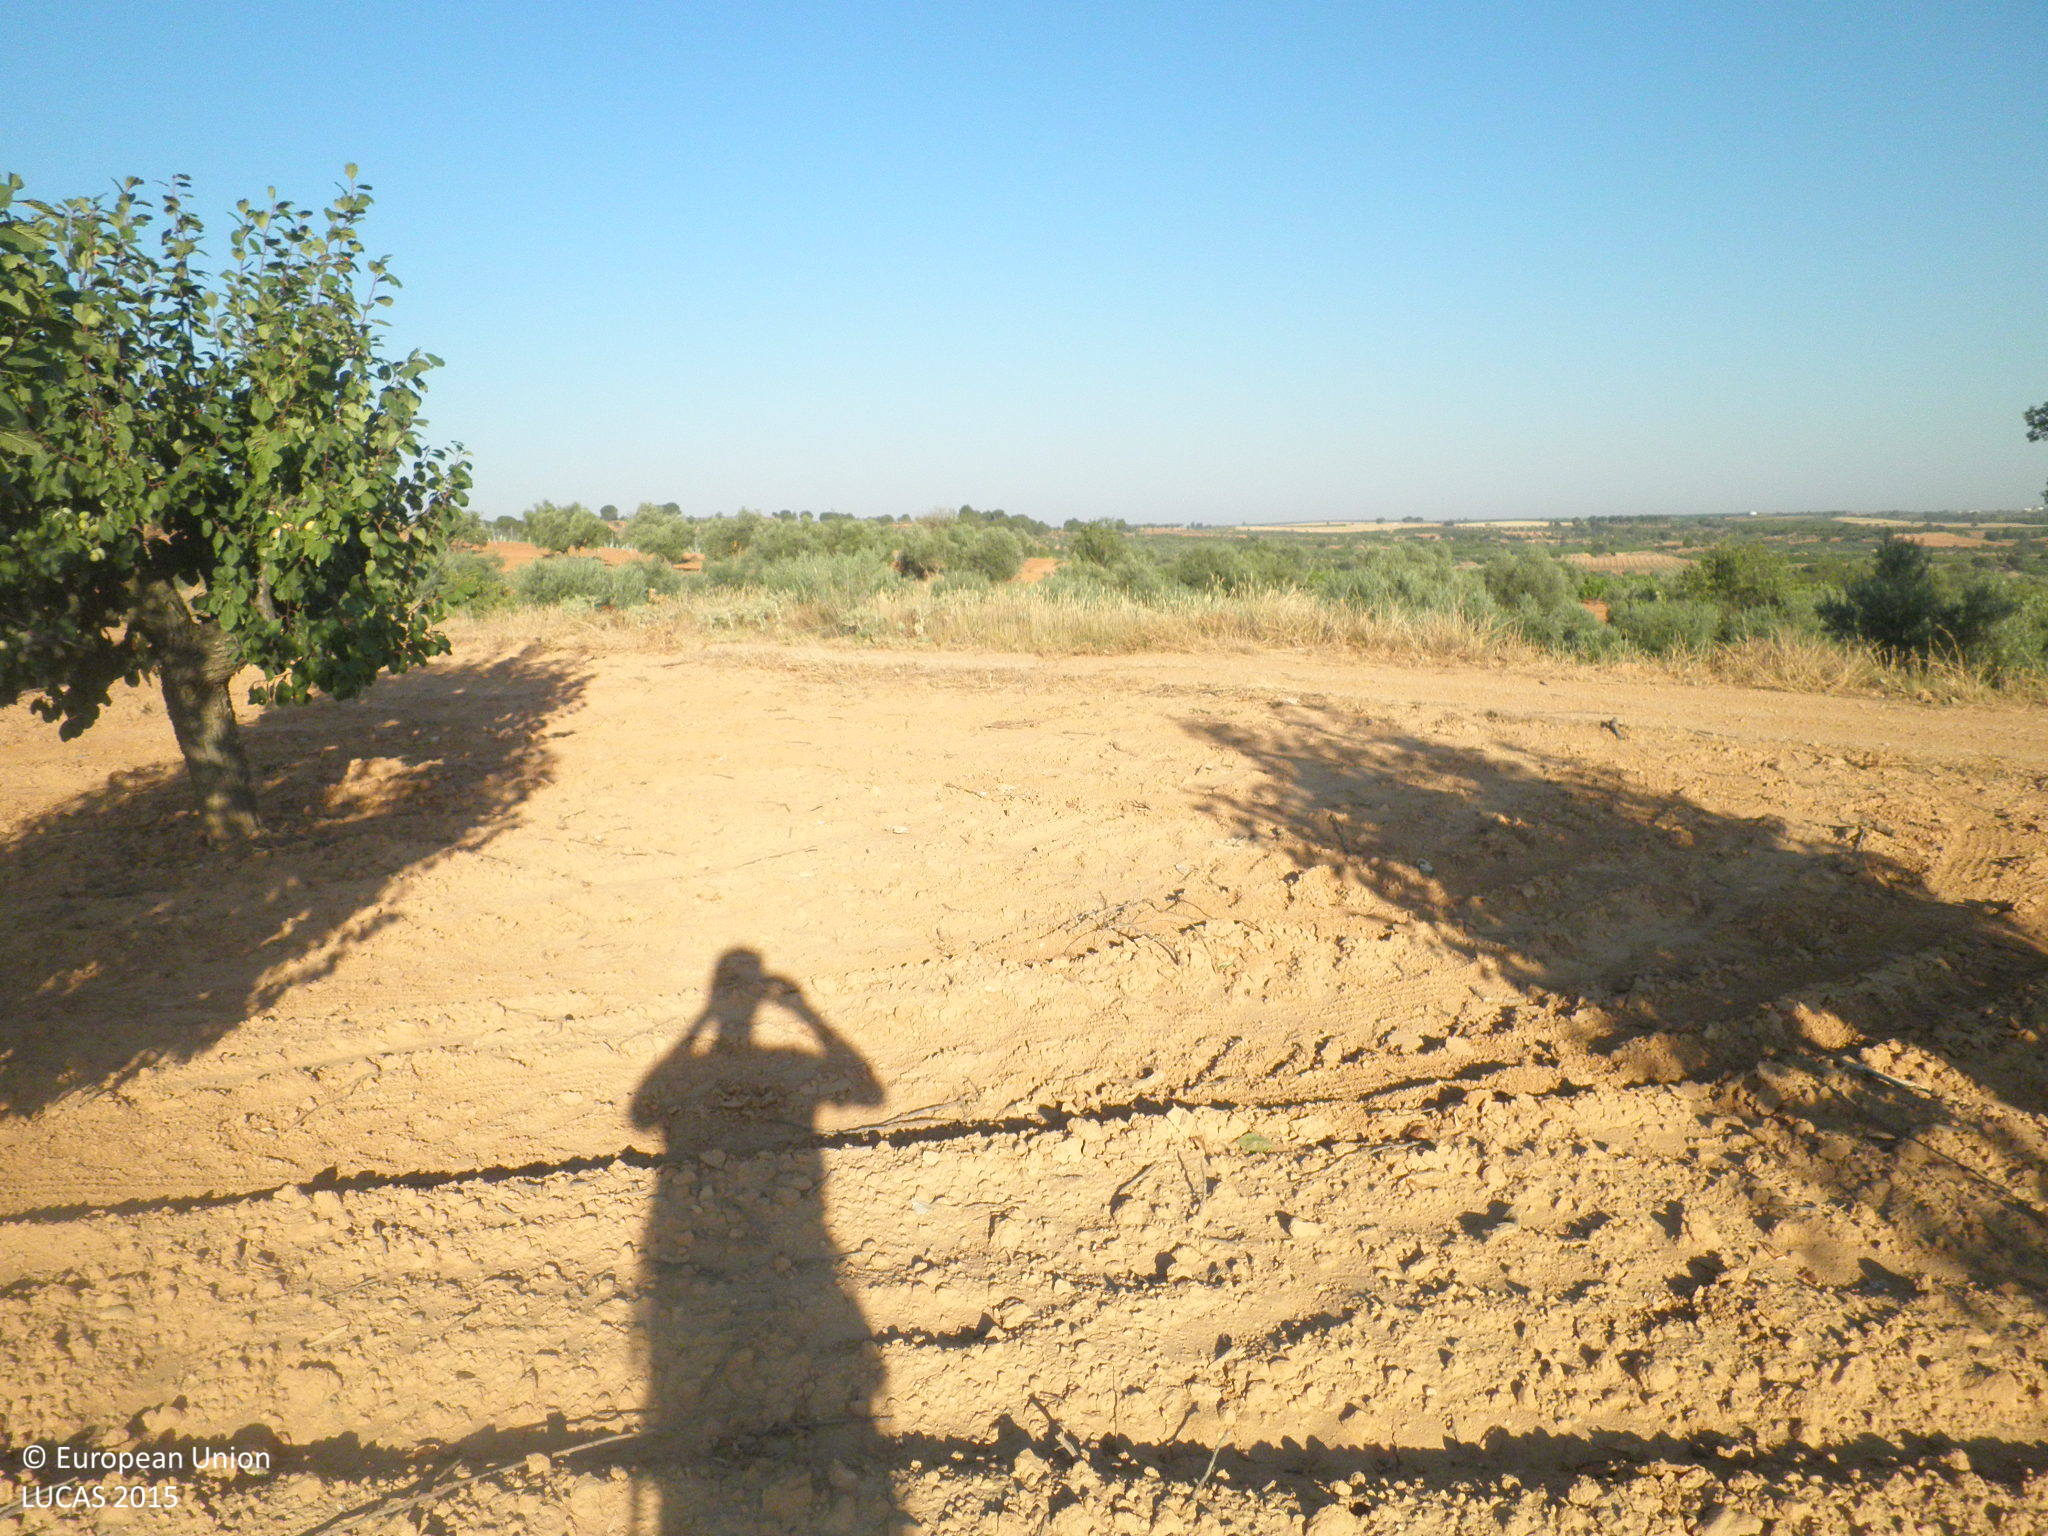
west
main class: Cropland
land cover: Other fruit trees and berries
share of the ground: 10 - 25 %
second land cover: Other bare soil
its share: > 75 %
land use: Agriculture (excluding fallow land and kitchen gardens)
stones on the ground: < 10 %
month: July
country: ES
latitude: 39.3786
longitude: -1.5771
